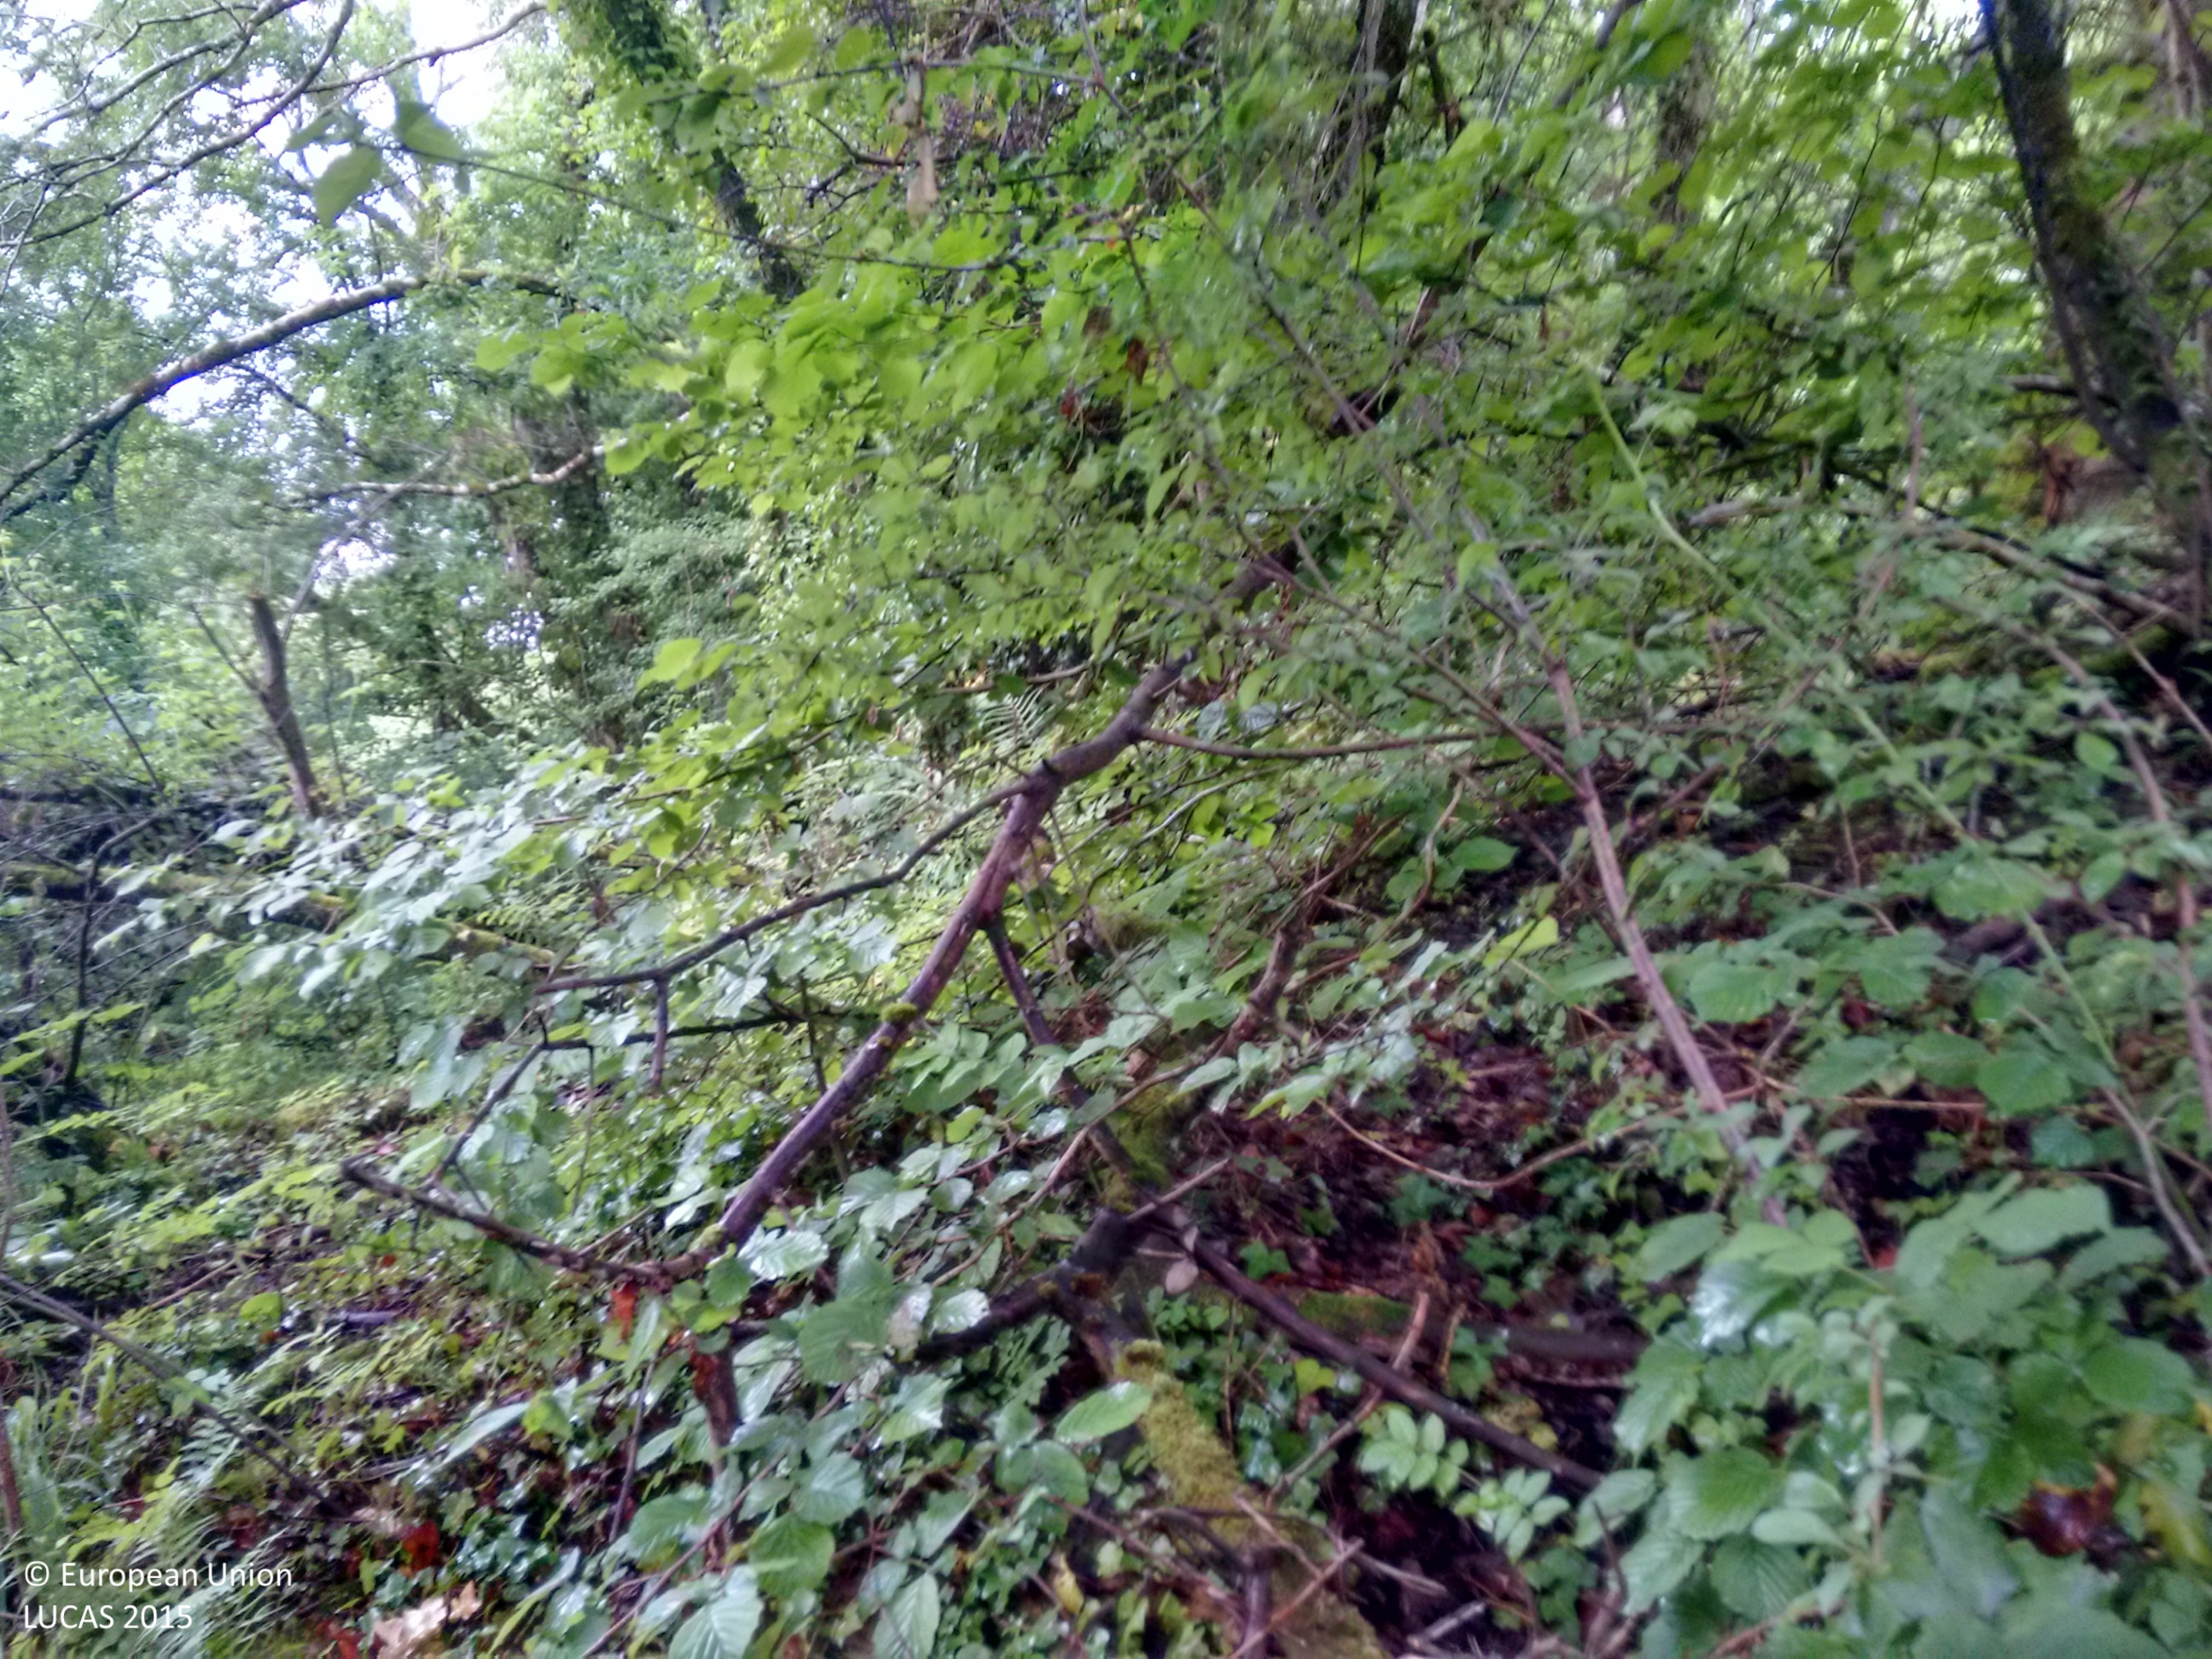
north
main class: Woodland
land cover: Broadleaved woodland
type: mesophytic deciduous forest
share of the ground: > 75 %
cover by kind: broadleaved forest trees 100 %
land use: Semi-natural and natural areas not in use
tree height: > 5 m
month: June
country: GB
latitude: 51.2833
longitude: -2.4386
